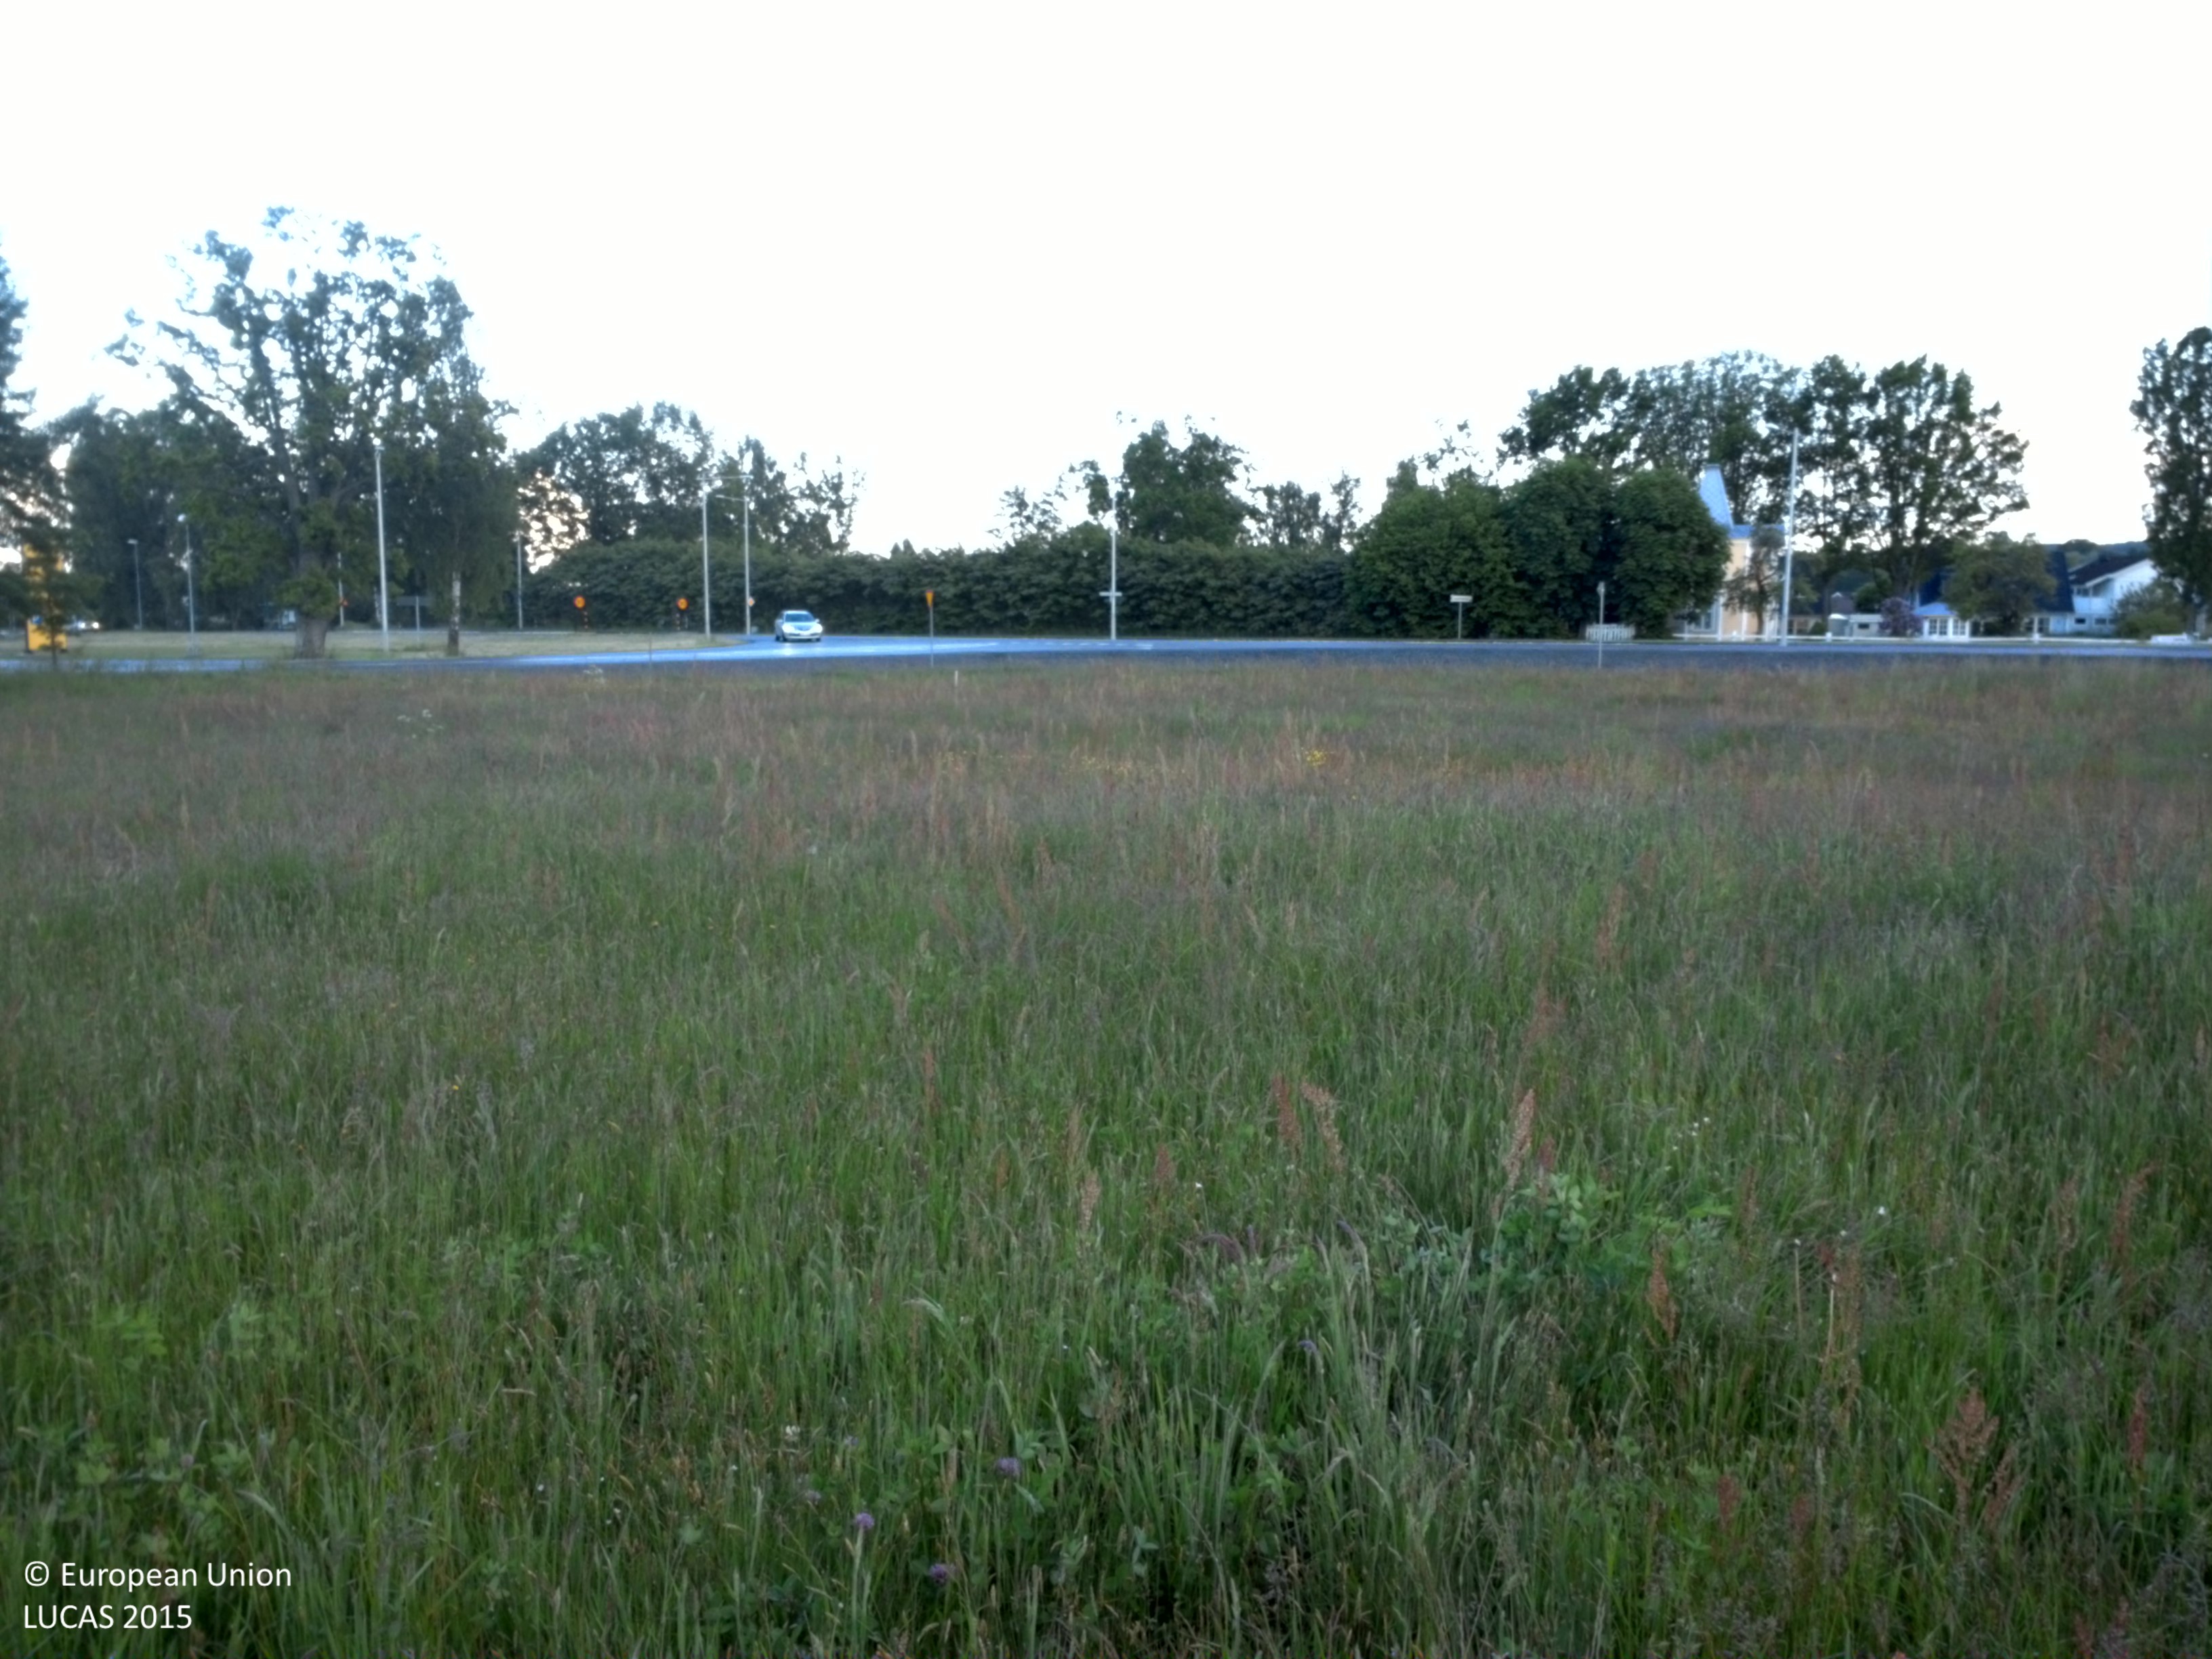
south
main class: Grassland
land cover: Grassland without tree/shrub cover
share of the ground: > 75 %
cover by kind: herbaceous plants 100 %
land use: Agriculture (excluding fallow land and kitchen gardens)
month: June
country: SE
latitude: 58.3136
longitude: 14.2782
